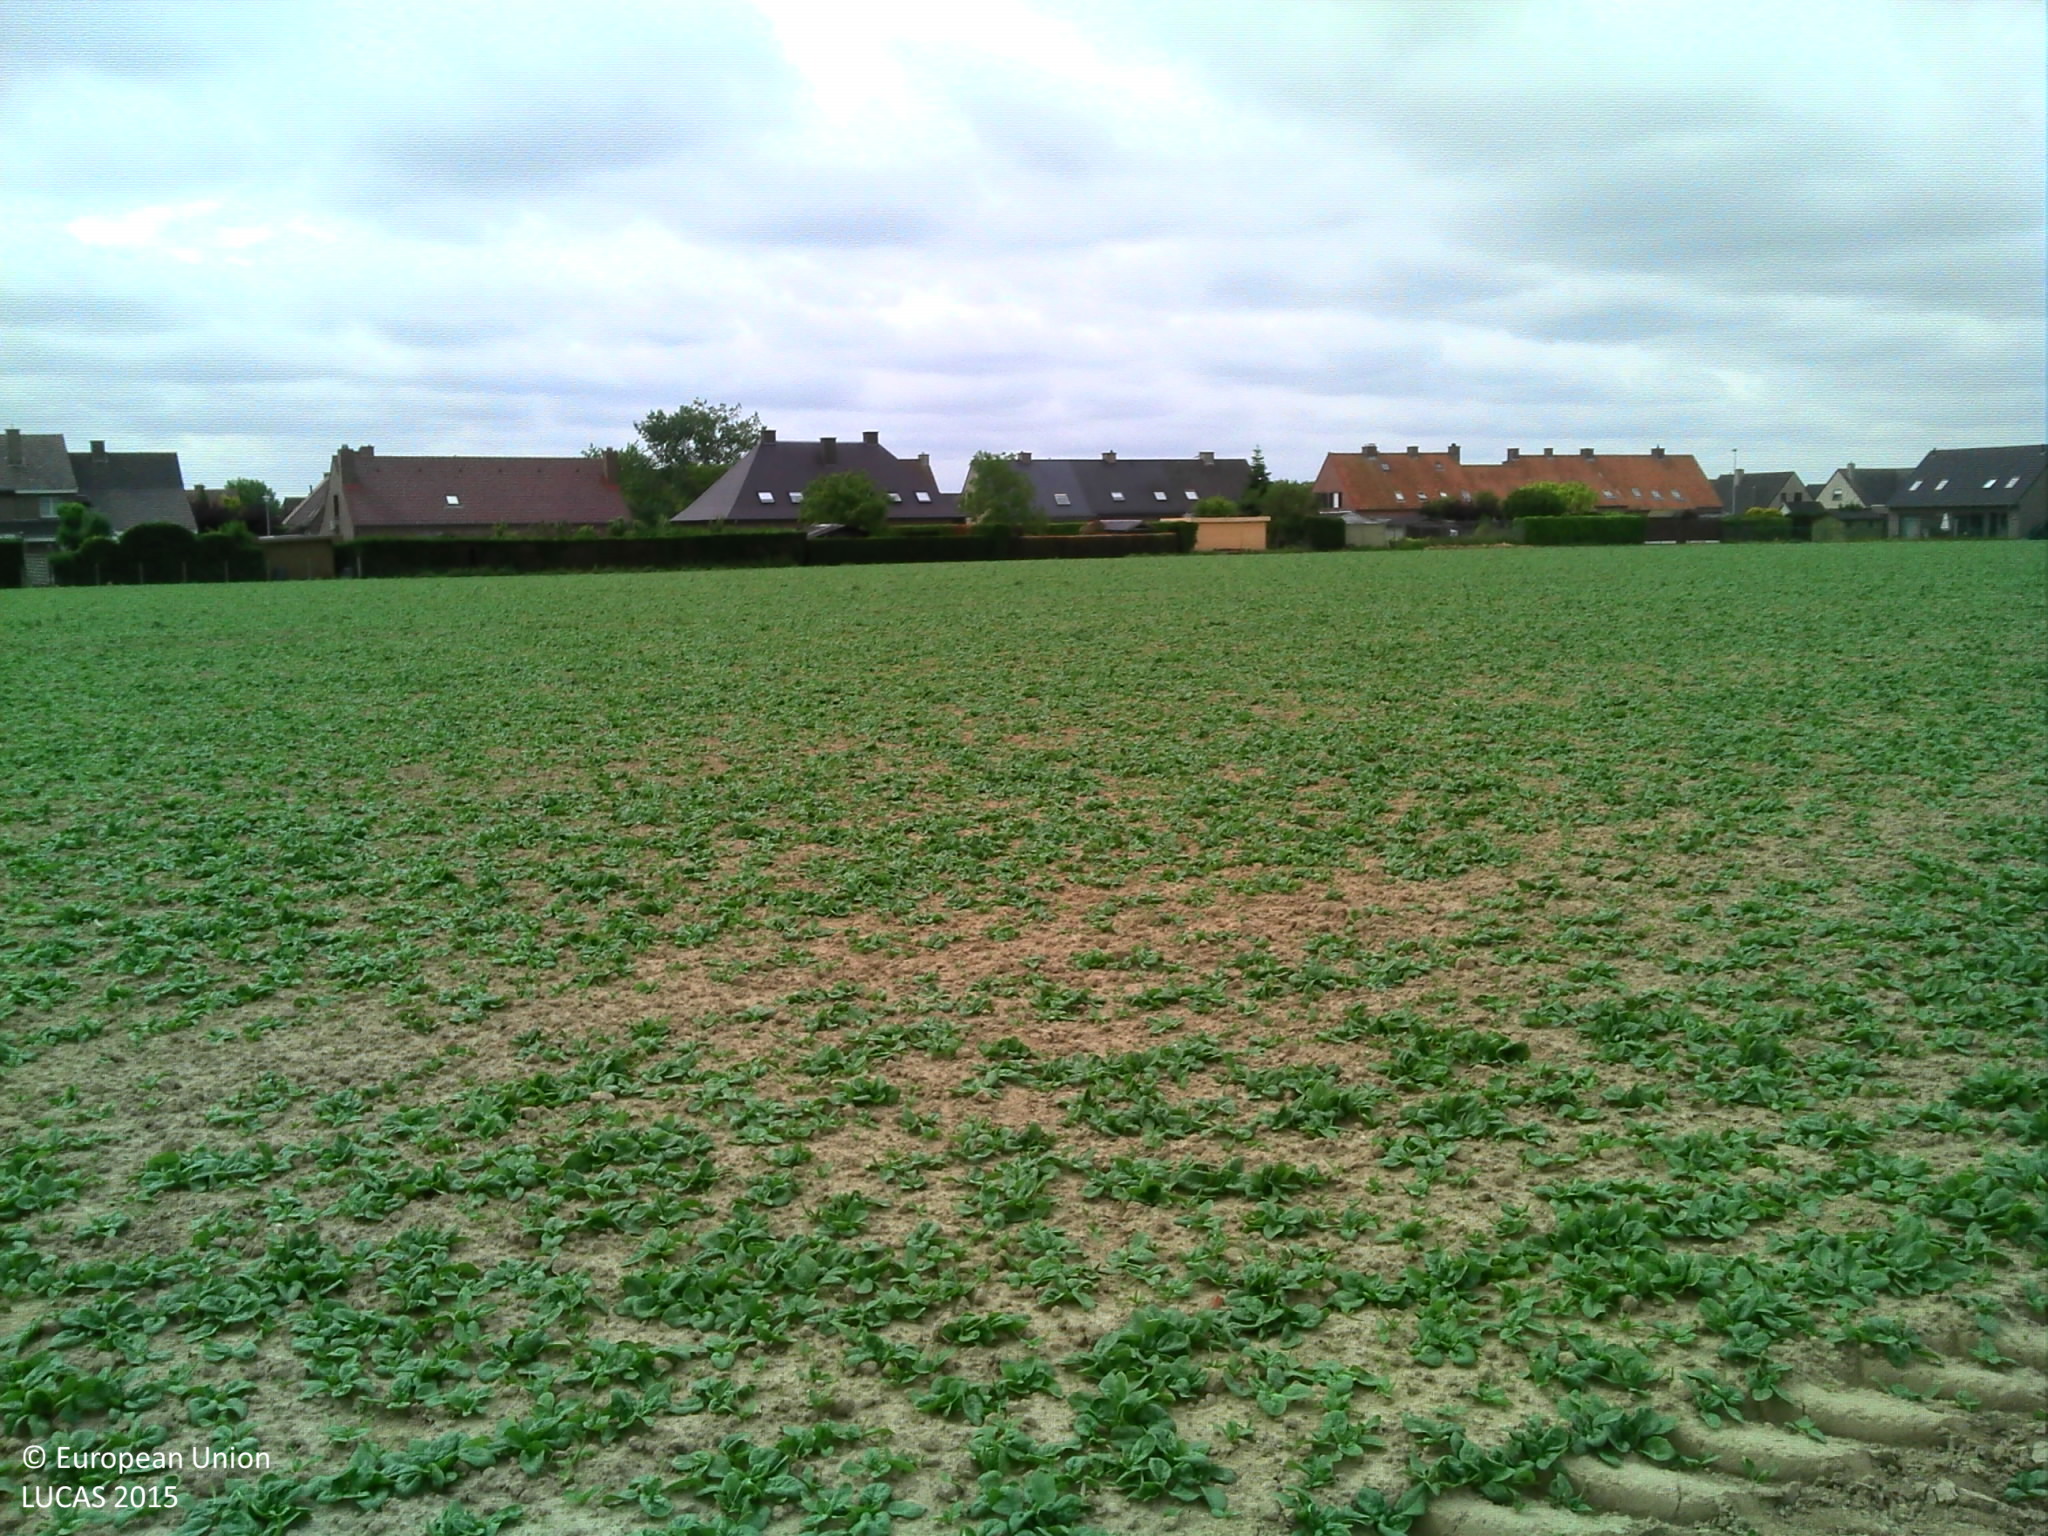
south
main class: Cropland
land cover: Other fresh vegetables
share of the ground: 50 - 75 %
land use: Agriculture (excluding fallow land and kitchen gardens)
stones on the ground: < 10 %
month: June
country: BE
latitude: 50.9685
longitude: 3.1125
